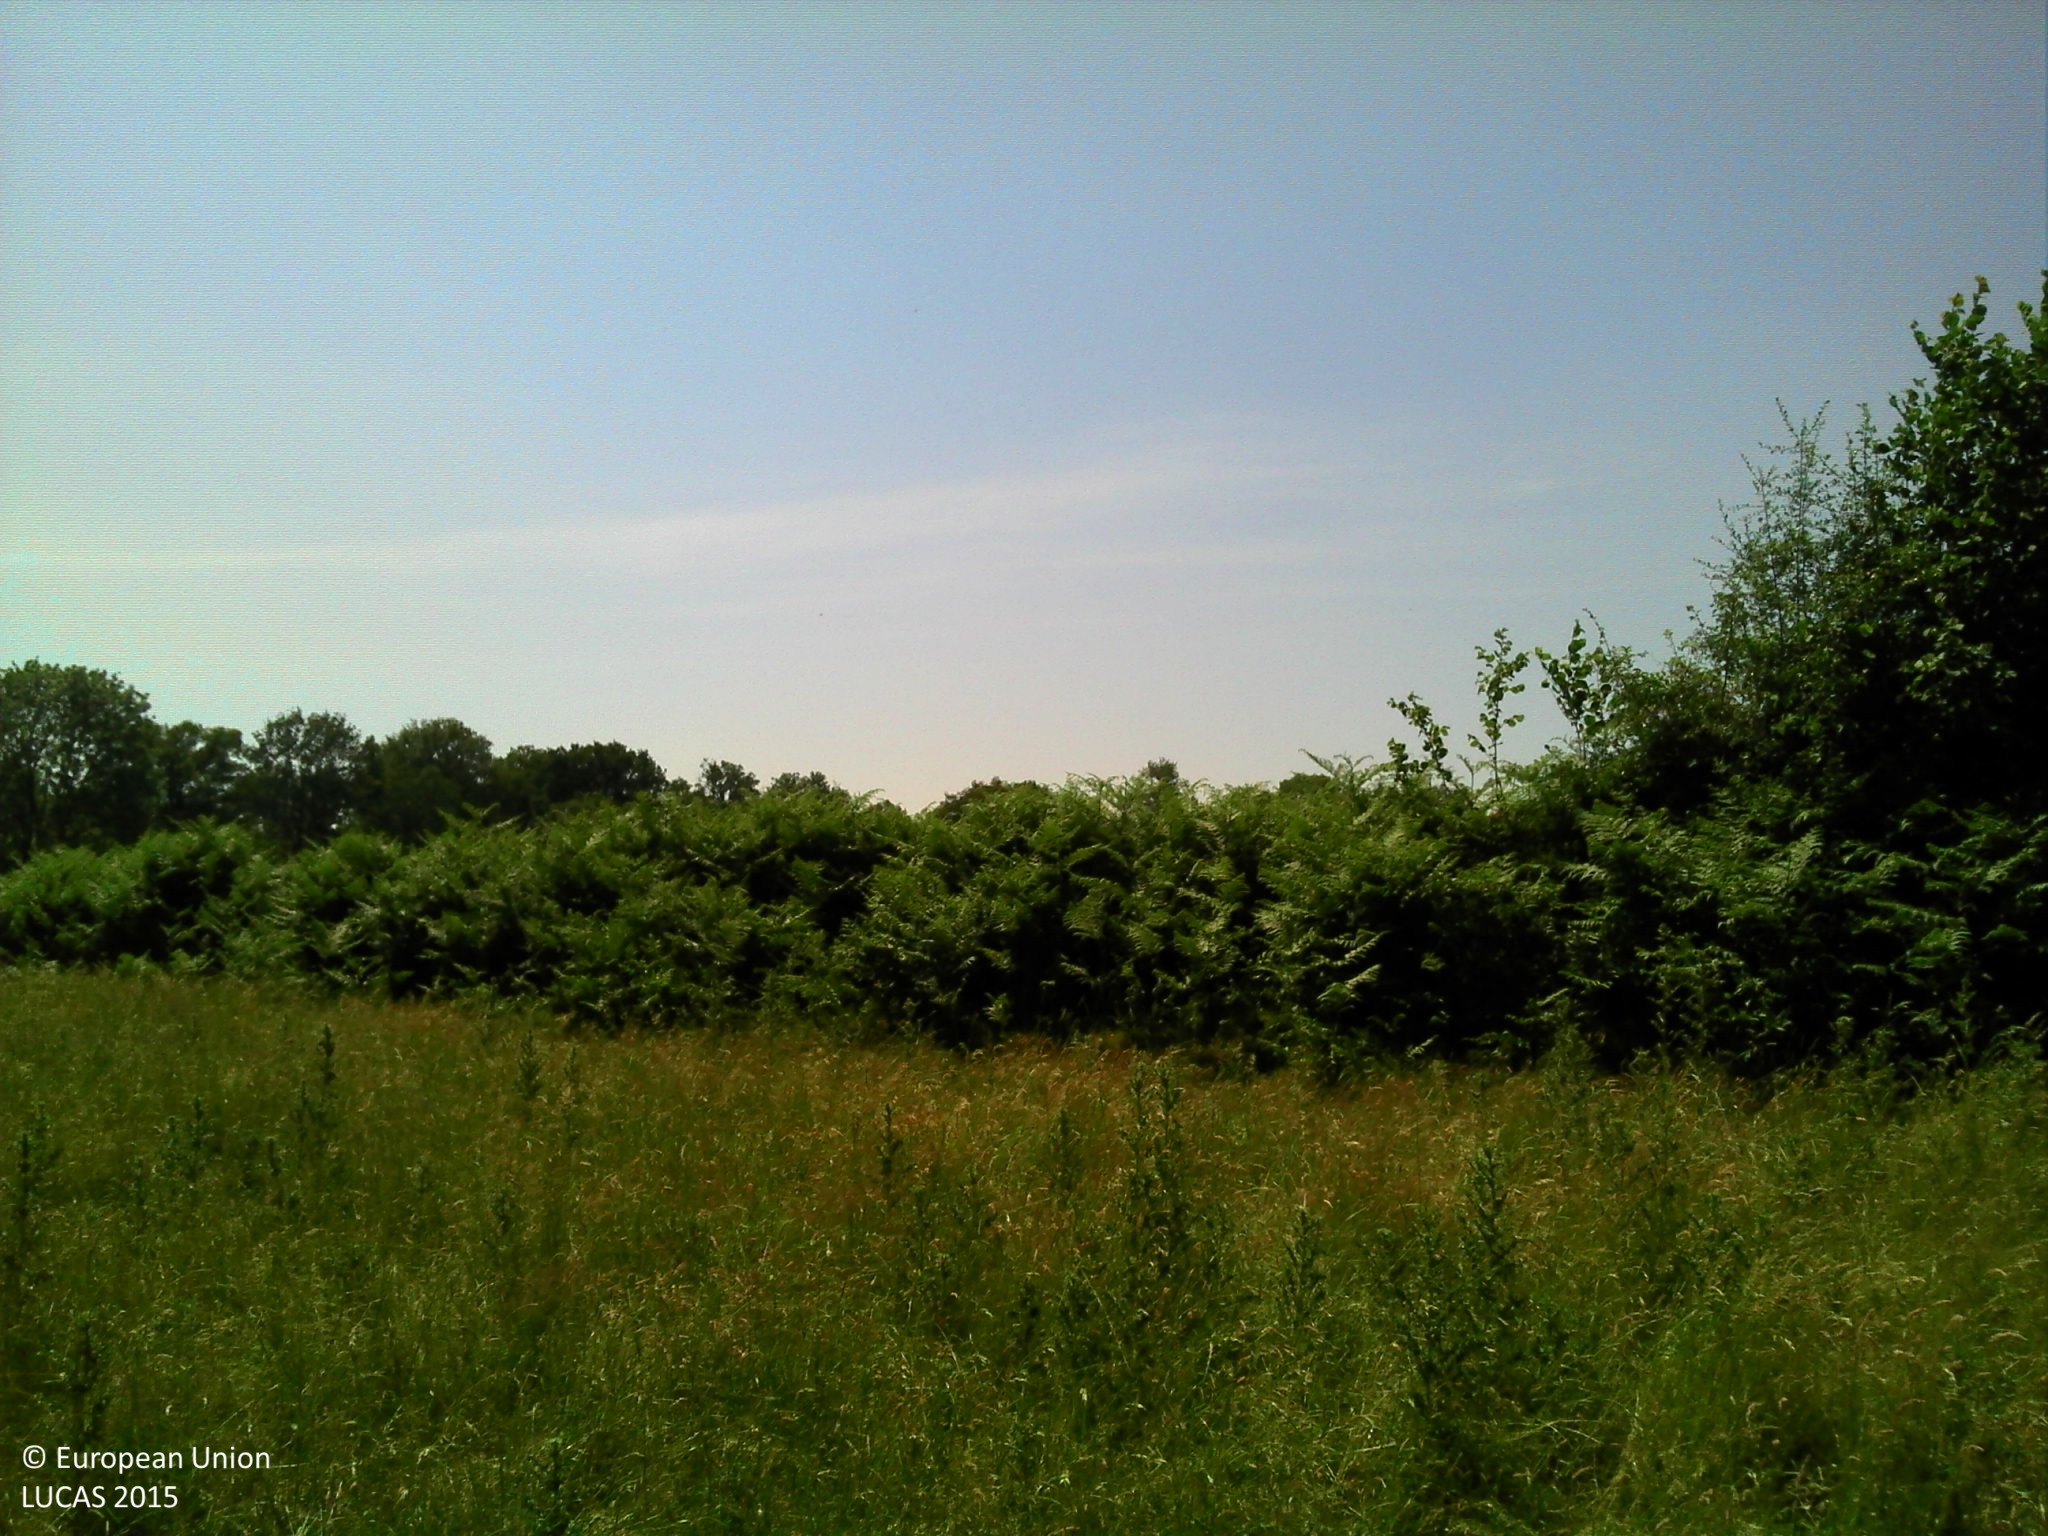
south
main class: Grassland
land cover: Grassland without tree/shrub cover
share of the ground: > 75 %
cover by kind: herbaceous plants 100 %
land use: Agriculture (excluding fallow land and kitchen gardens)
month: June
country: FR
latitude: 46.3742
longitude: 2.9903
